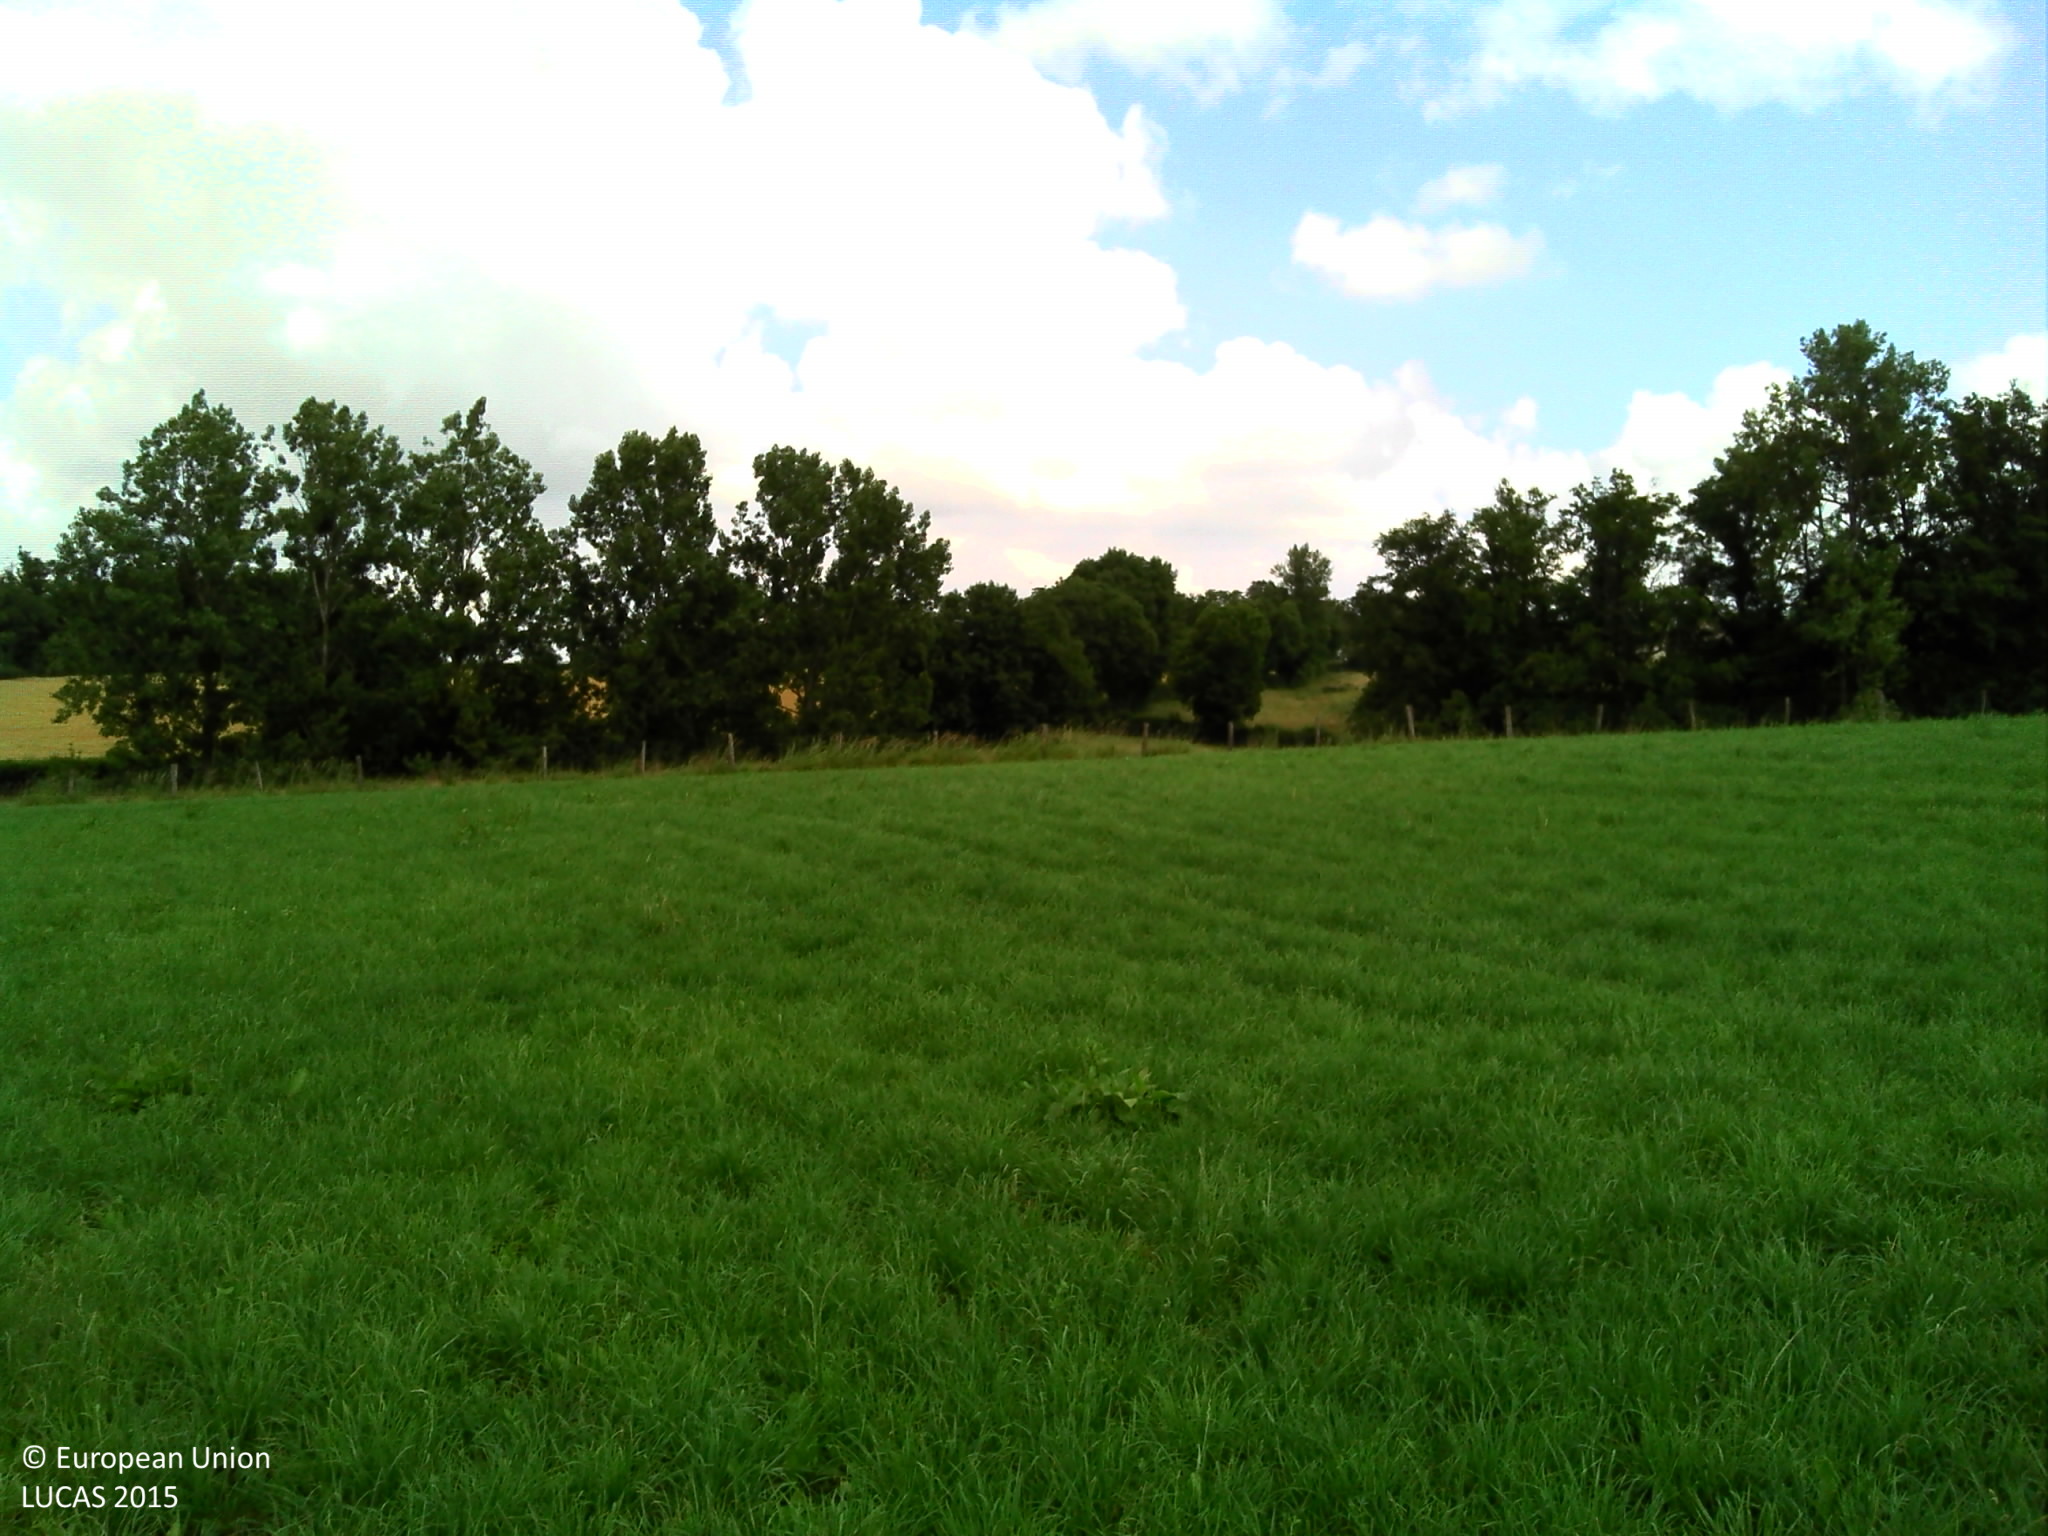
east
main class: Cropland
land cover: Temporary grasslands
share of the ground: > 75 %
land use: Agriculture (excluding fallow land and kitchen gardens)
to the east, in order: Temporary grasslands; Fences; Grassland without tree/shrub cover; Broadleaved woodland; Rivers and streams; Broadleaved woodland; Grassland without tree/shrub cover; Fences; Managed hedges; Barley; Broadleaved woodland; Fences; Barley
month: June
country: FR
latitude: 44.3013
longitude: 2.5706
